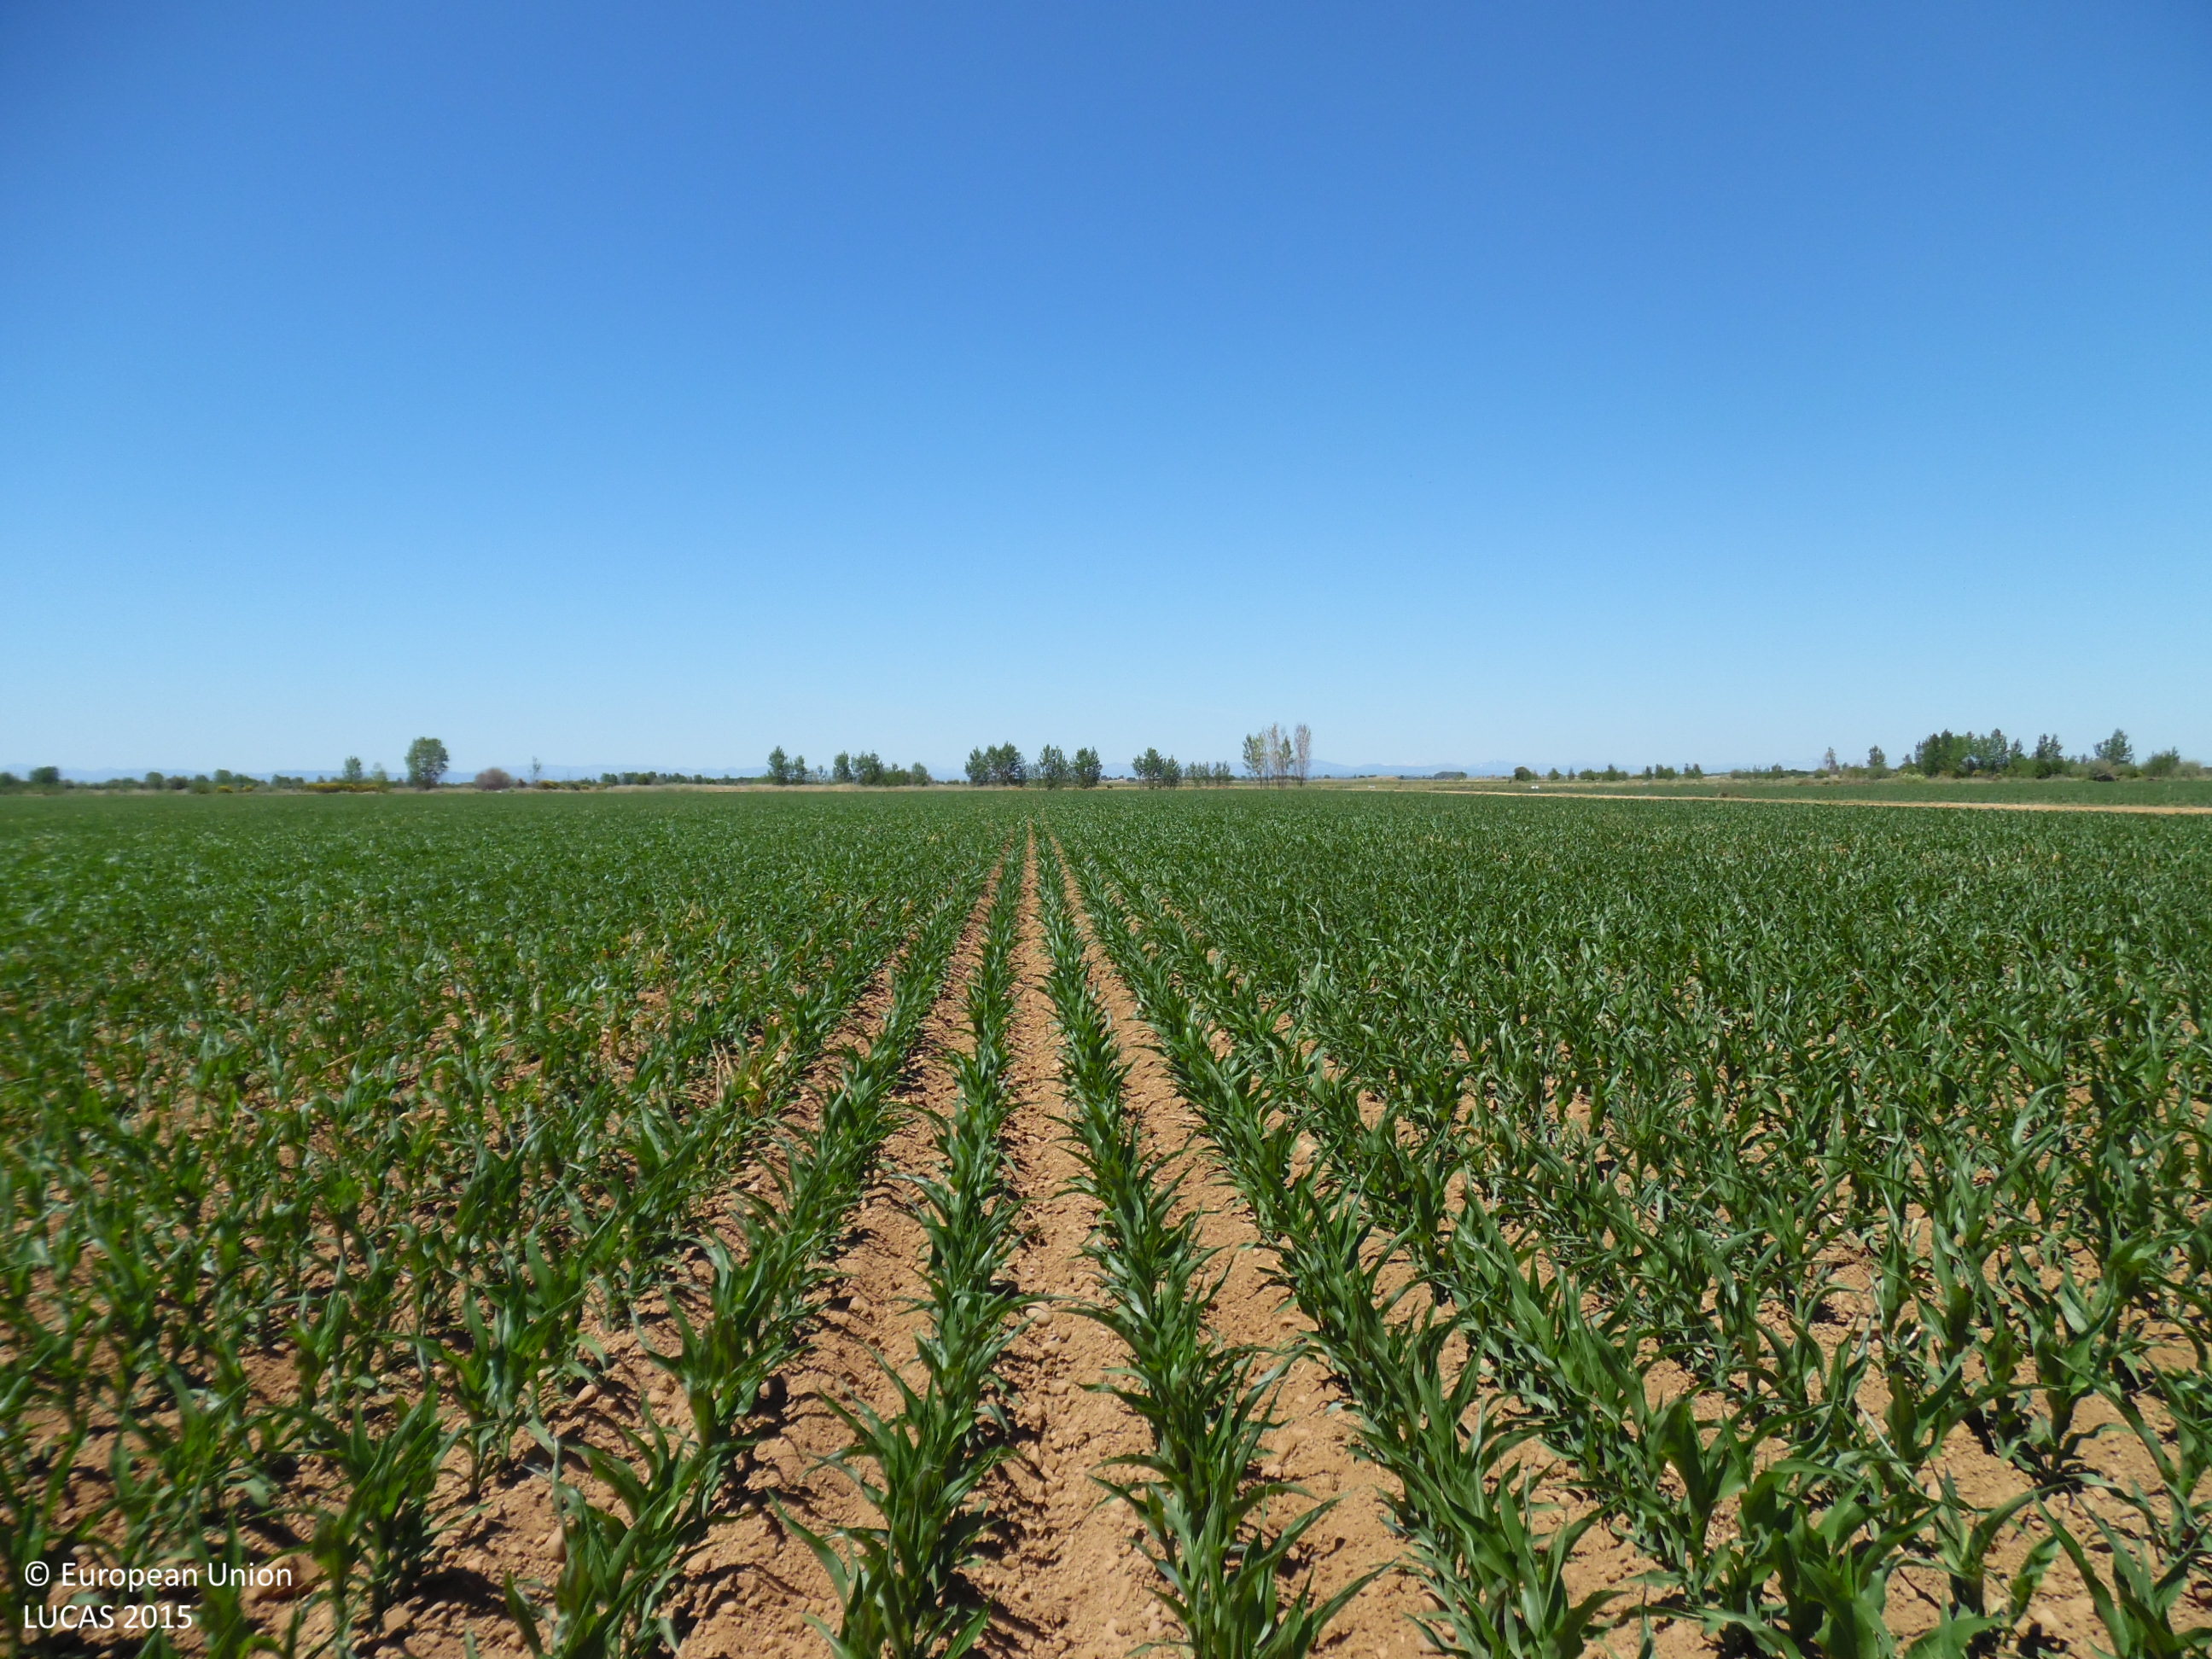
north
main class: Cropland
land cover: Maize
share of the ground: 25 - 50 %
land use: Agriculture (excluding fallow land and kitchen gardens)
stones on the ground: 10 - 25 %
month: June
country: ES
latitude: 42.3890
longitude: -5.7312
